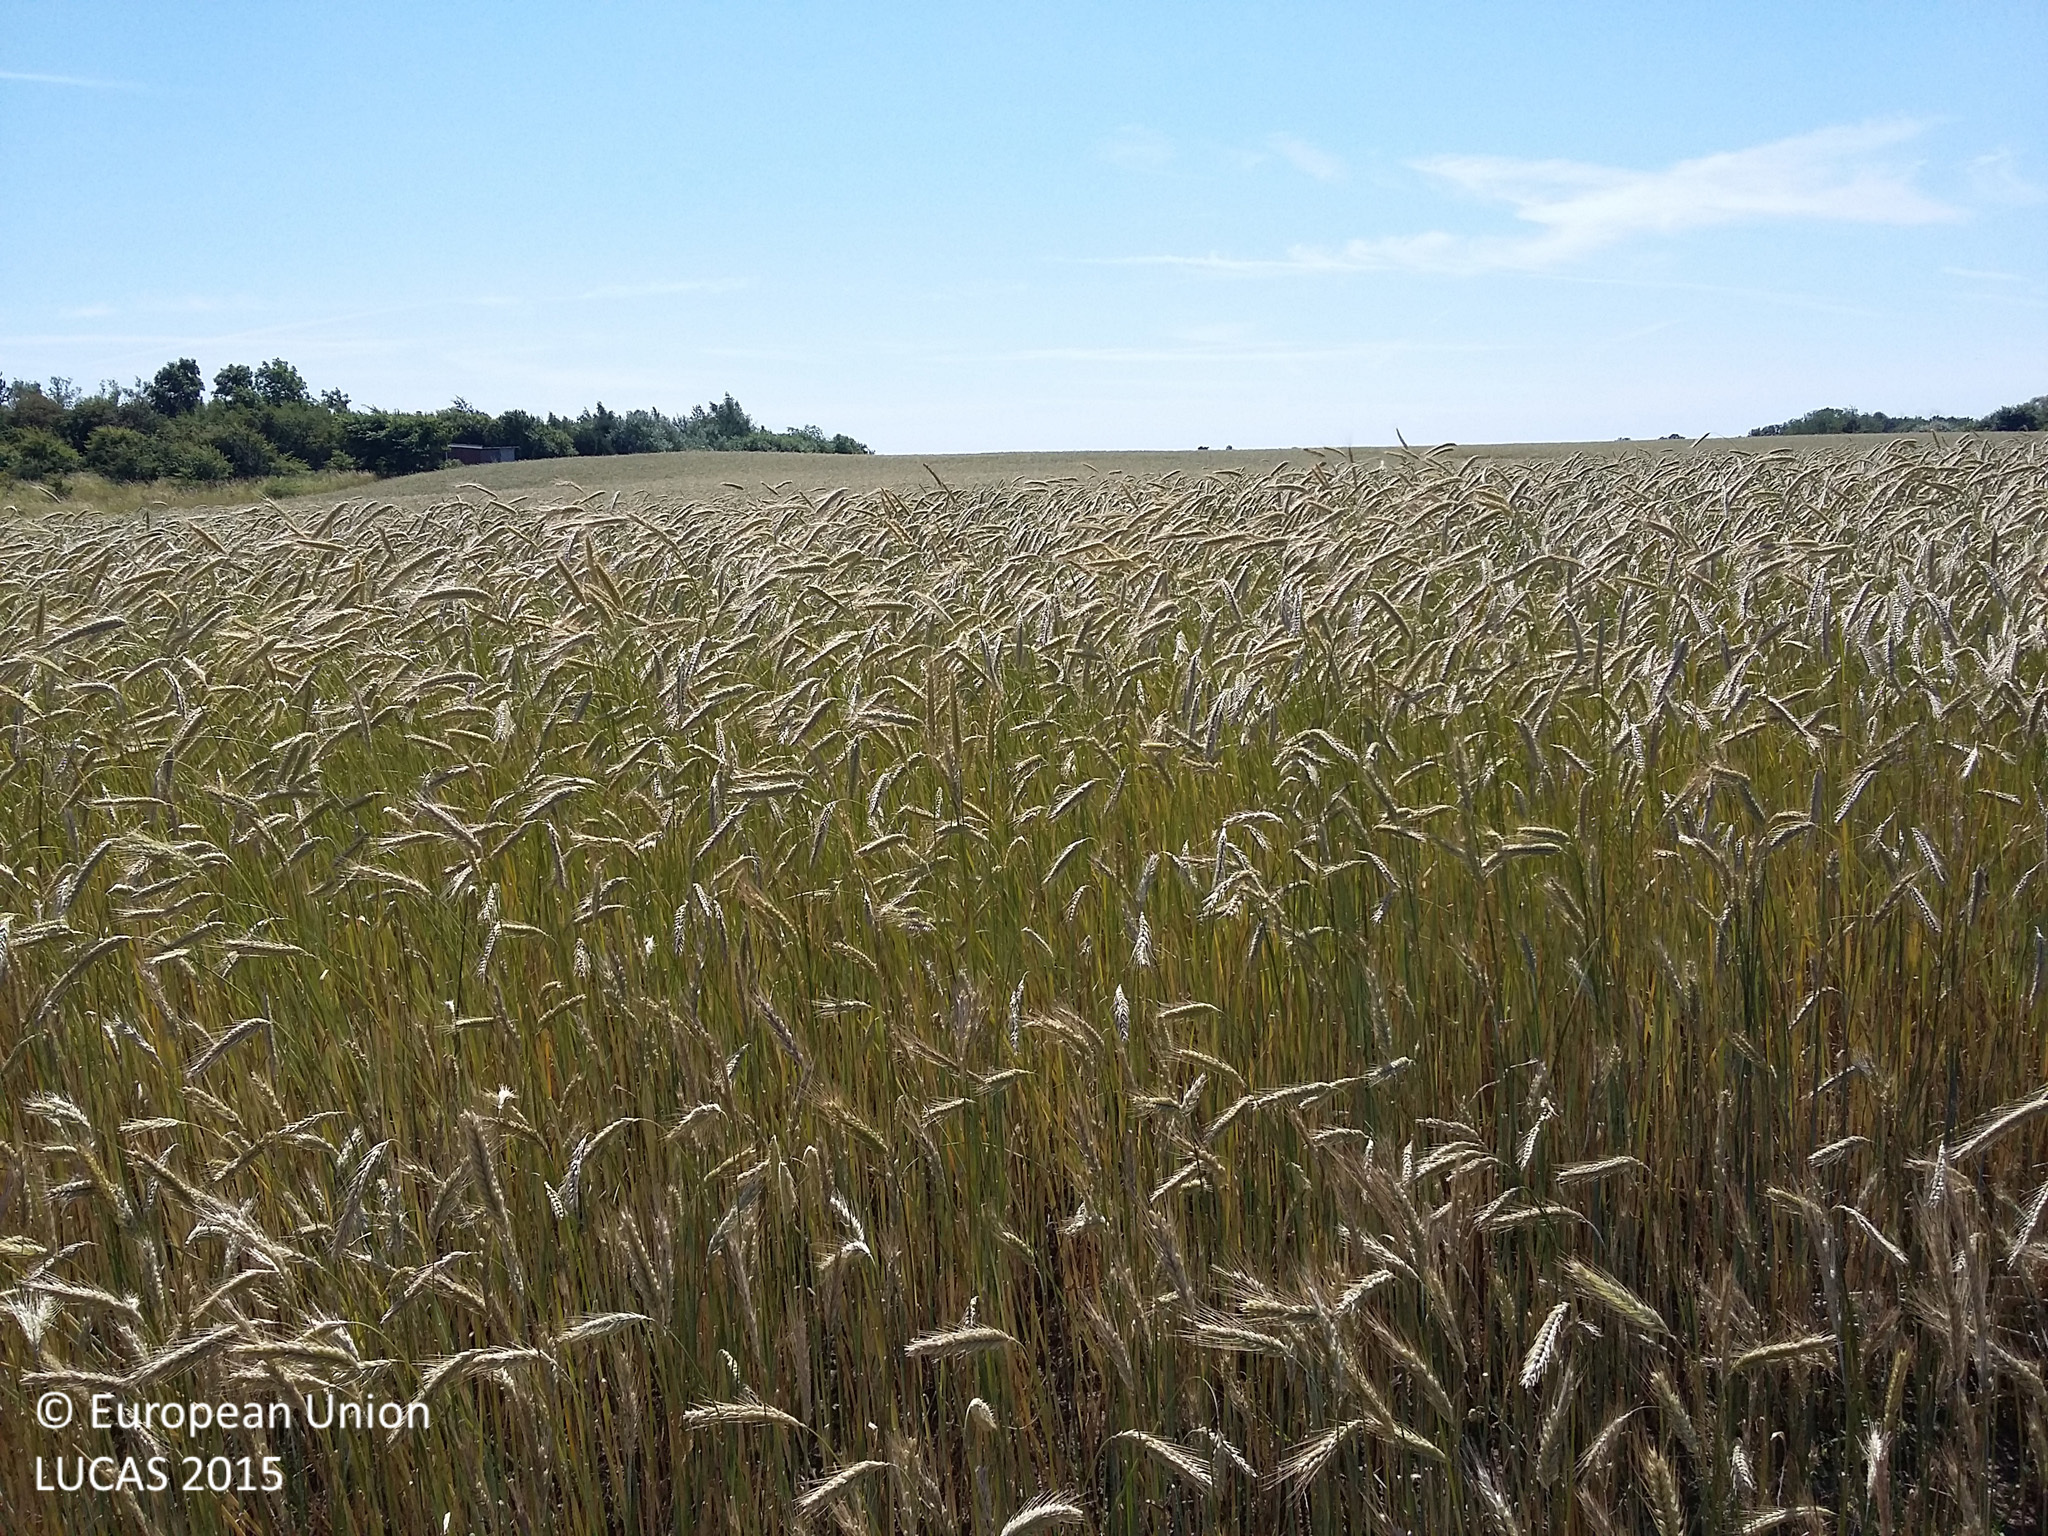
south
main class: Cropland
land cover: Rye
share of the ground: > 75 %
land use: Agriculture (excluding fallow land and kitchen gardens)
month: July
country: DK
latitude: 55.5677
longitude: 11.5051
